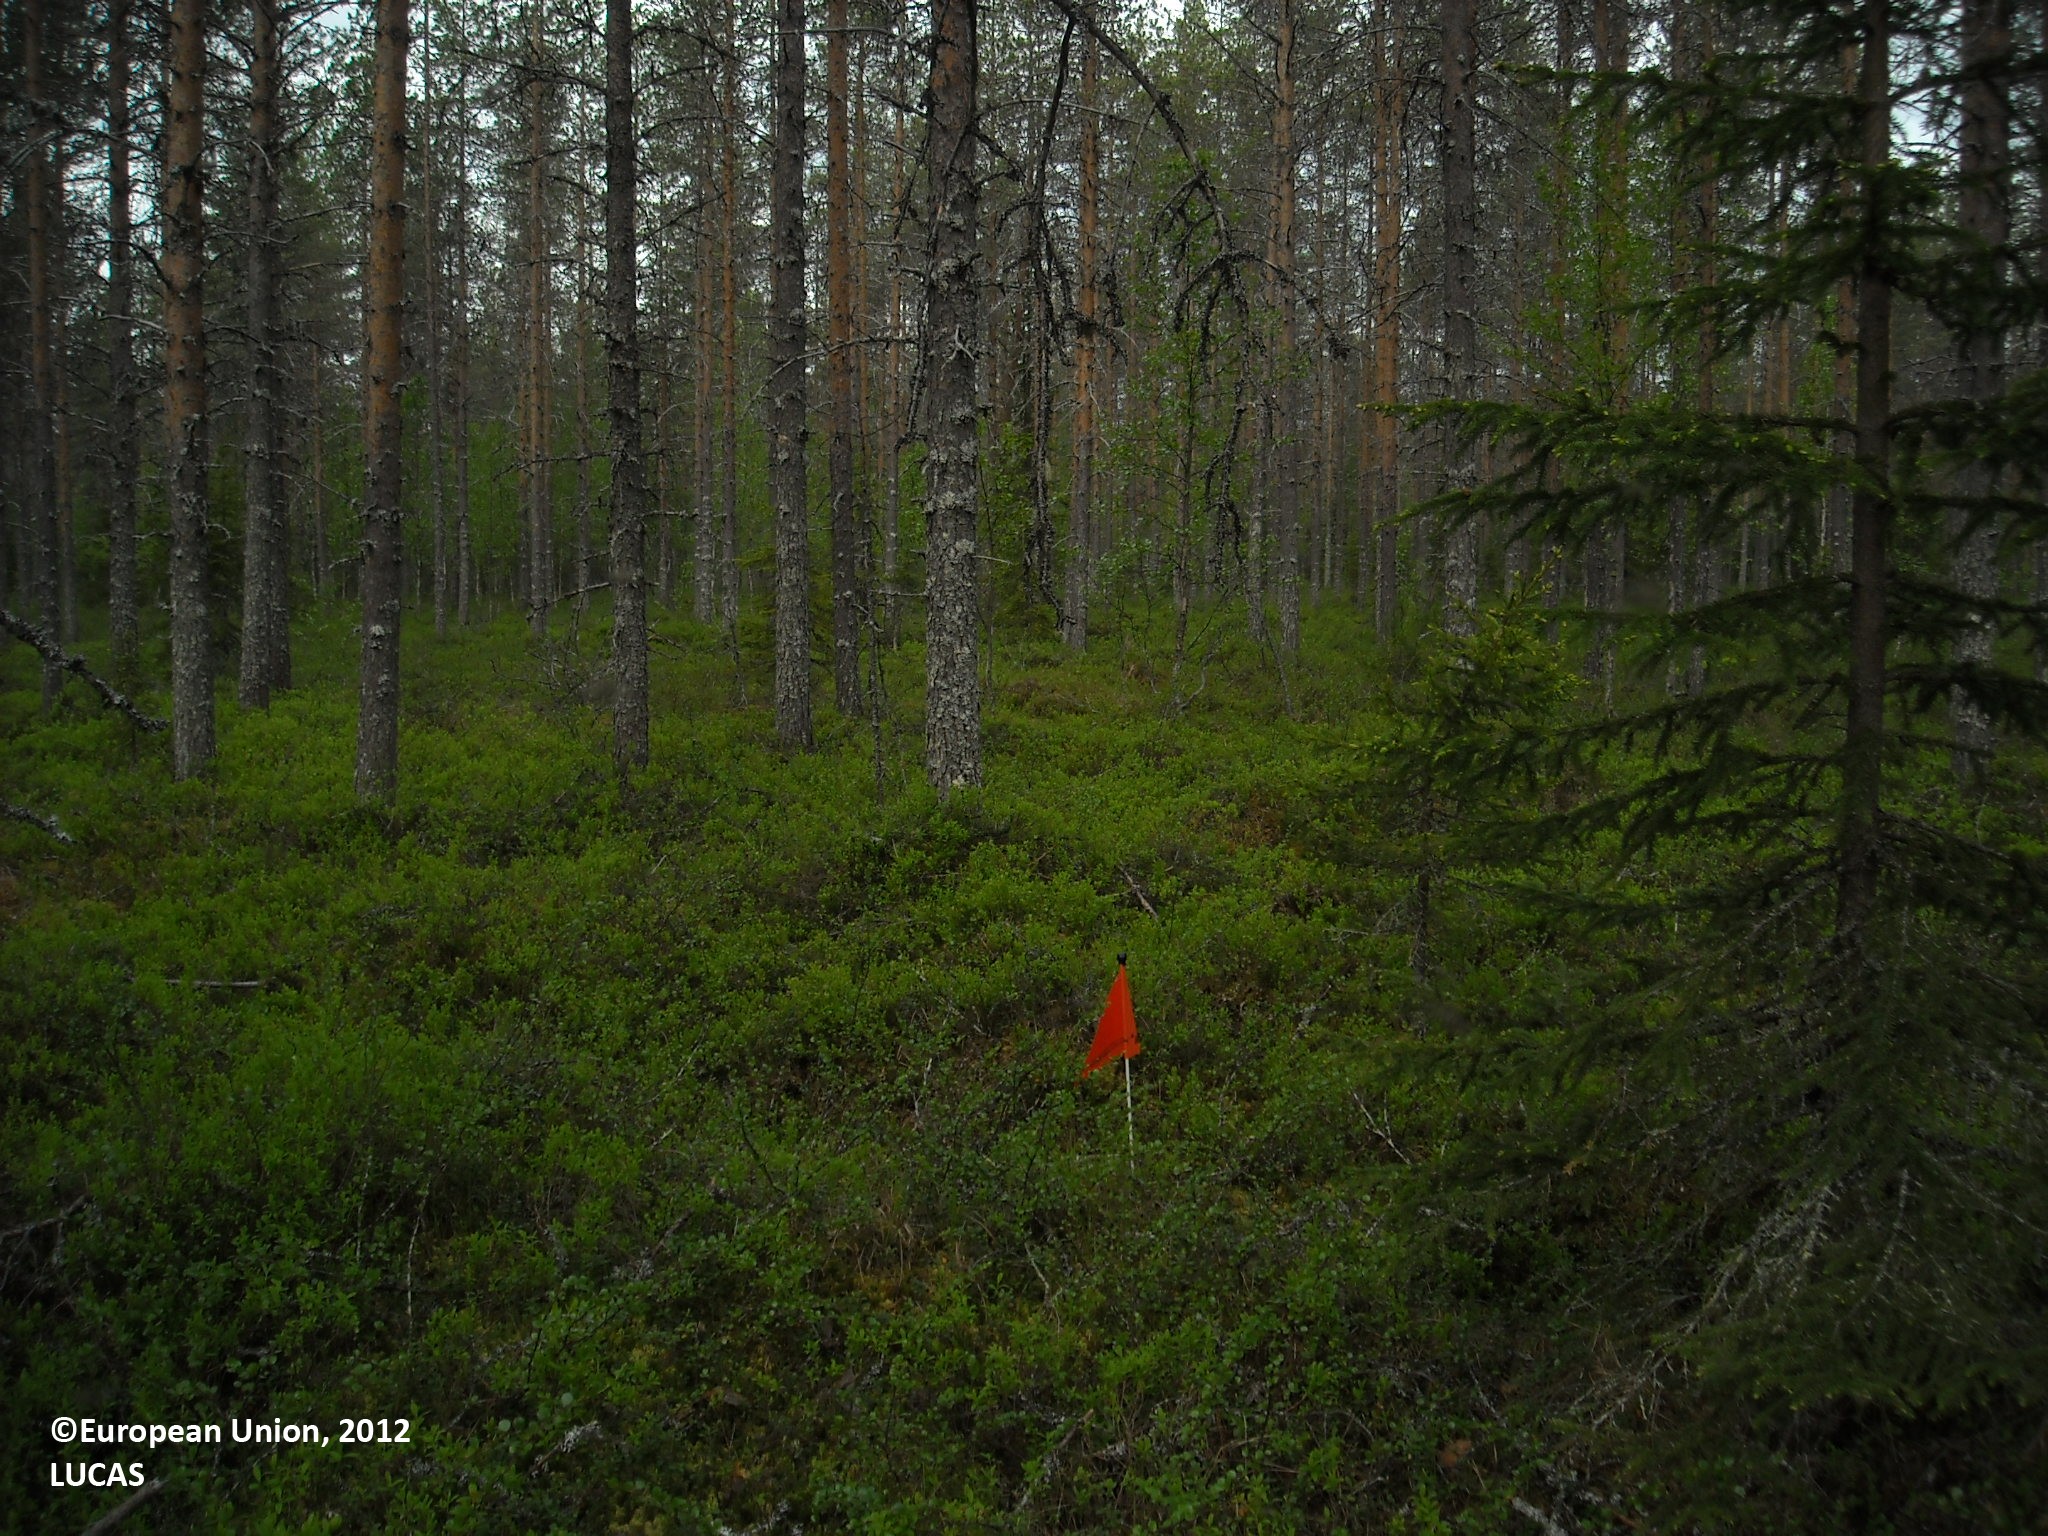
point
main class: Woodland
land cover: Pine dominated coniferous woodland
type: boreal forest
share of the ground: 50 - 75 %
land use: Forestry
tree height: > 5 m
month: June
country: FI
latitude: 65.5897
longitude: 28.0353
